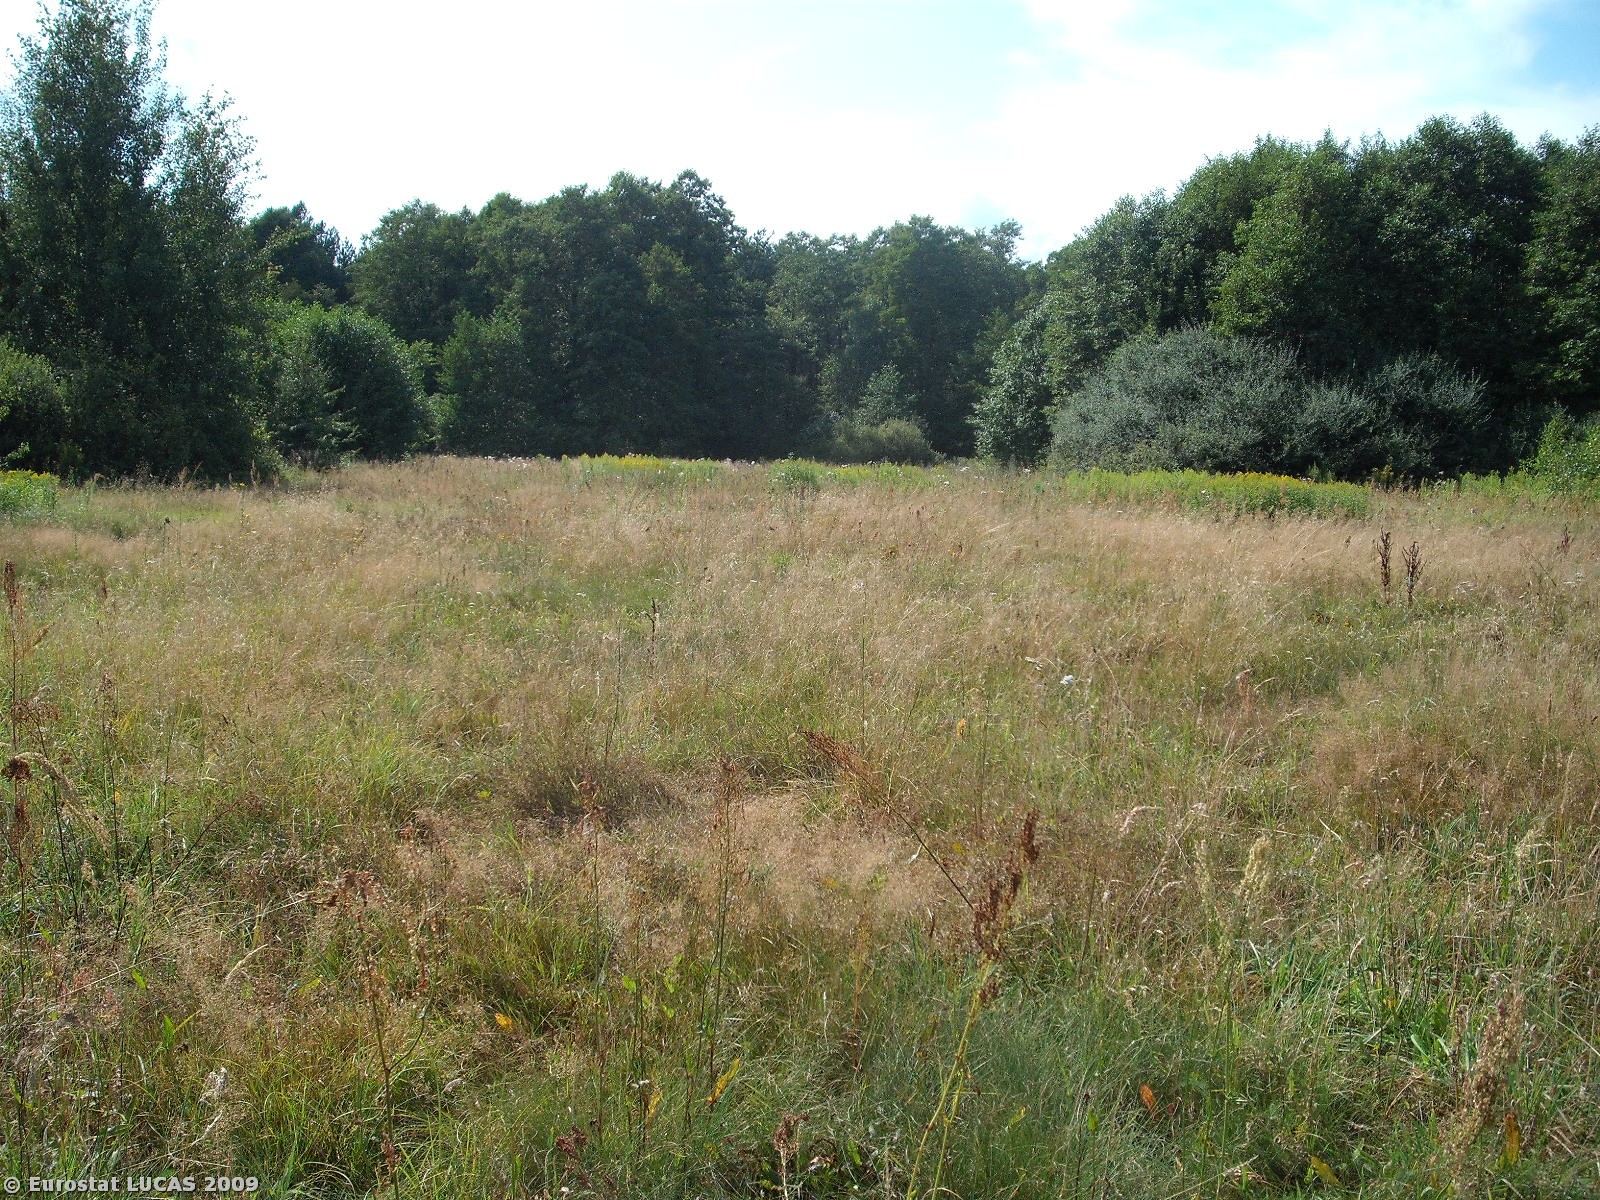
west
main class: Grassland
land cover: Grassland without tree/shrub cover
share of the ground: > 75 %
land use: Agriculture (excluding fallow land and kitchen gardens)
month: August
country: PL
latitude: 51.8054
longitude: 21.6115
